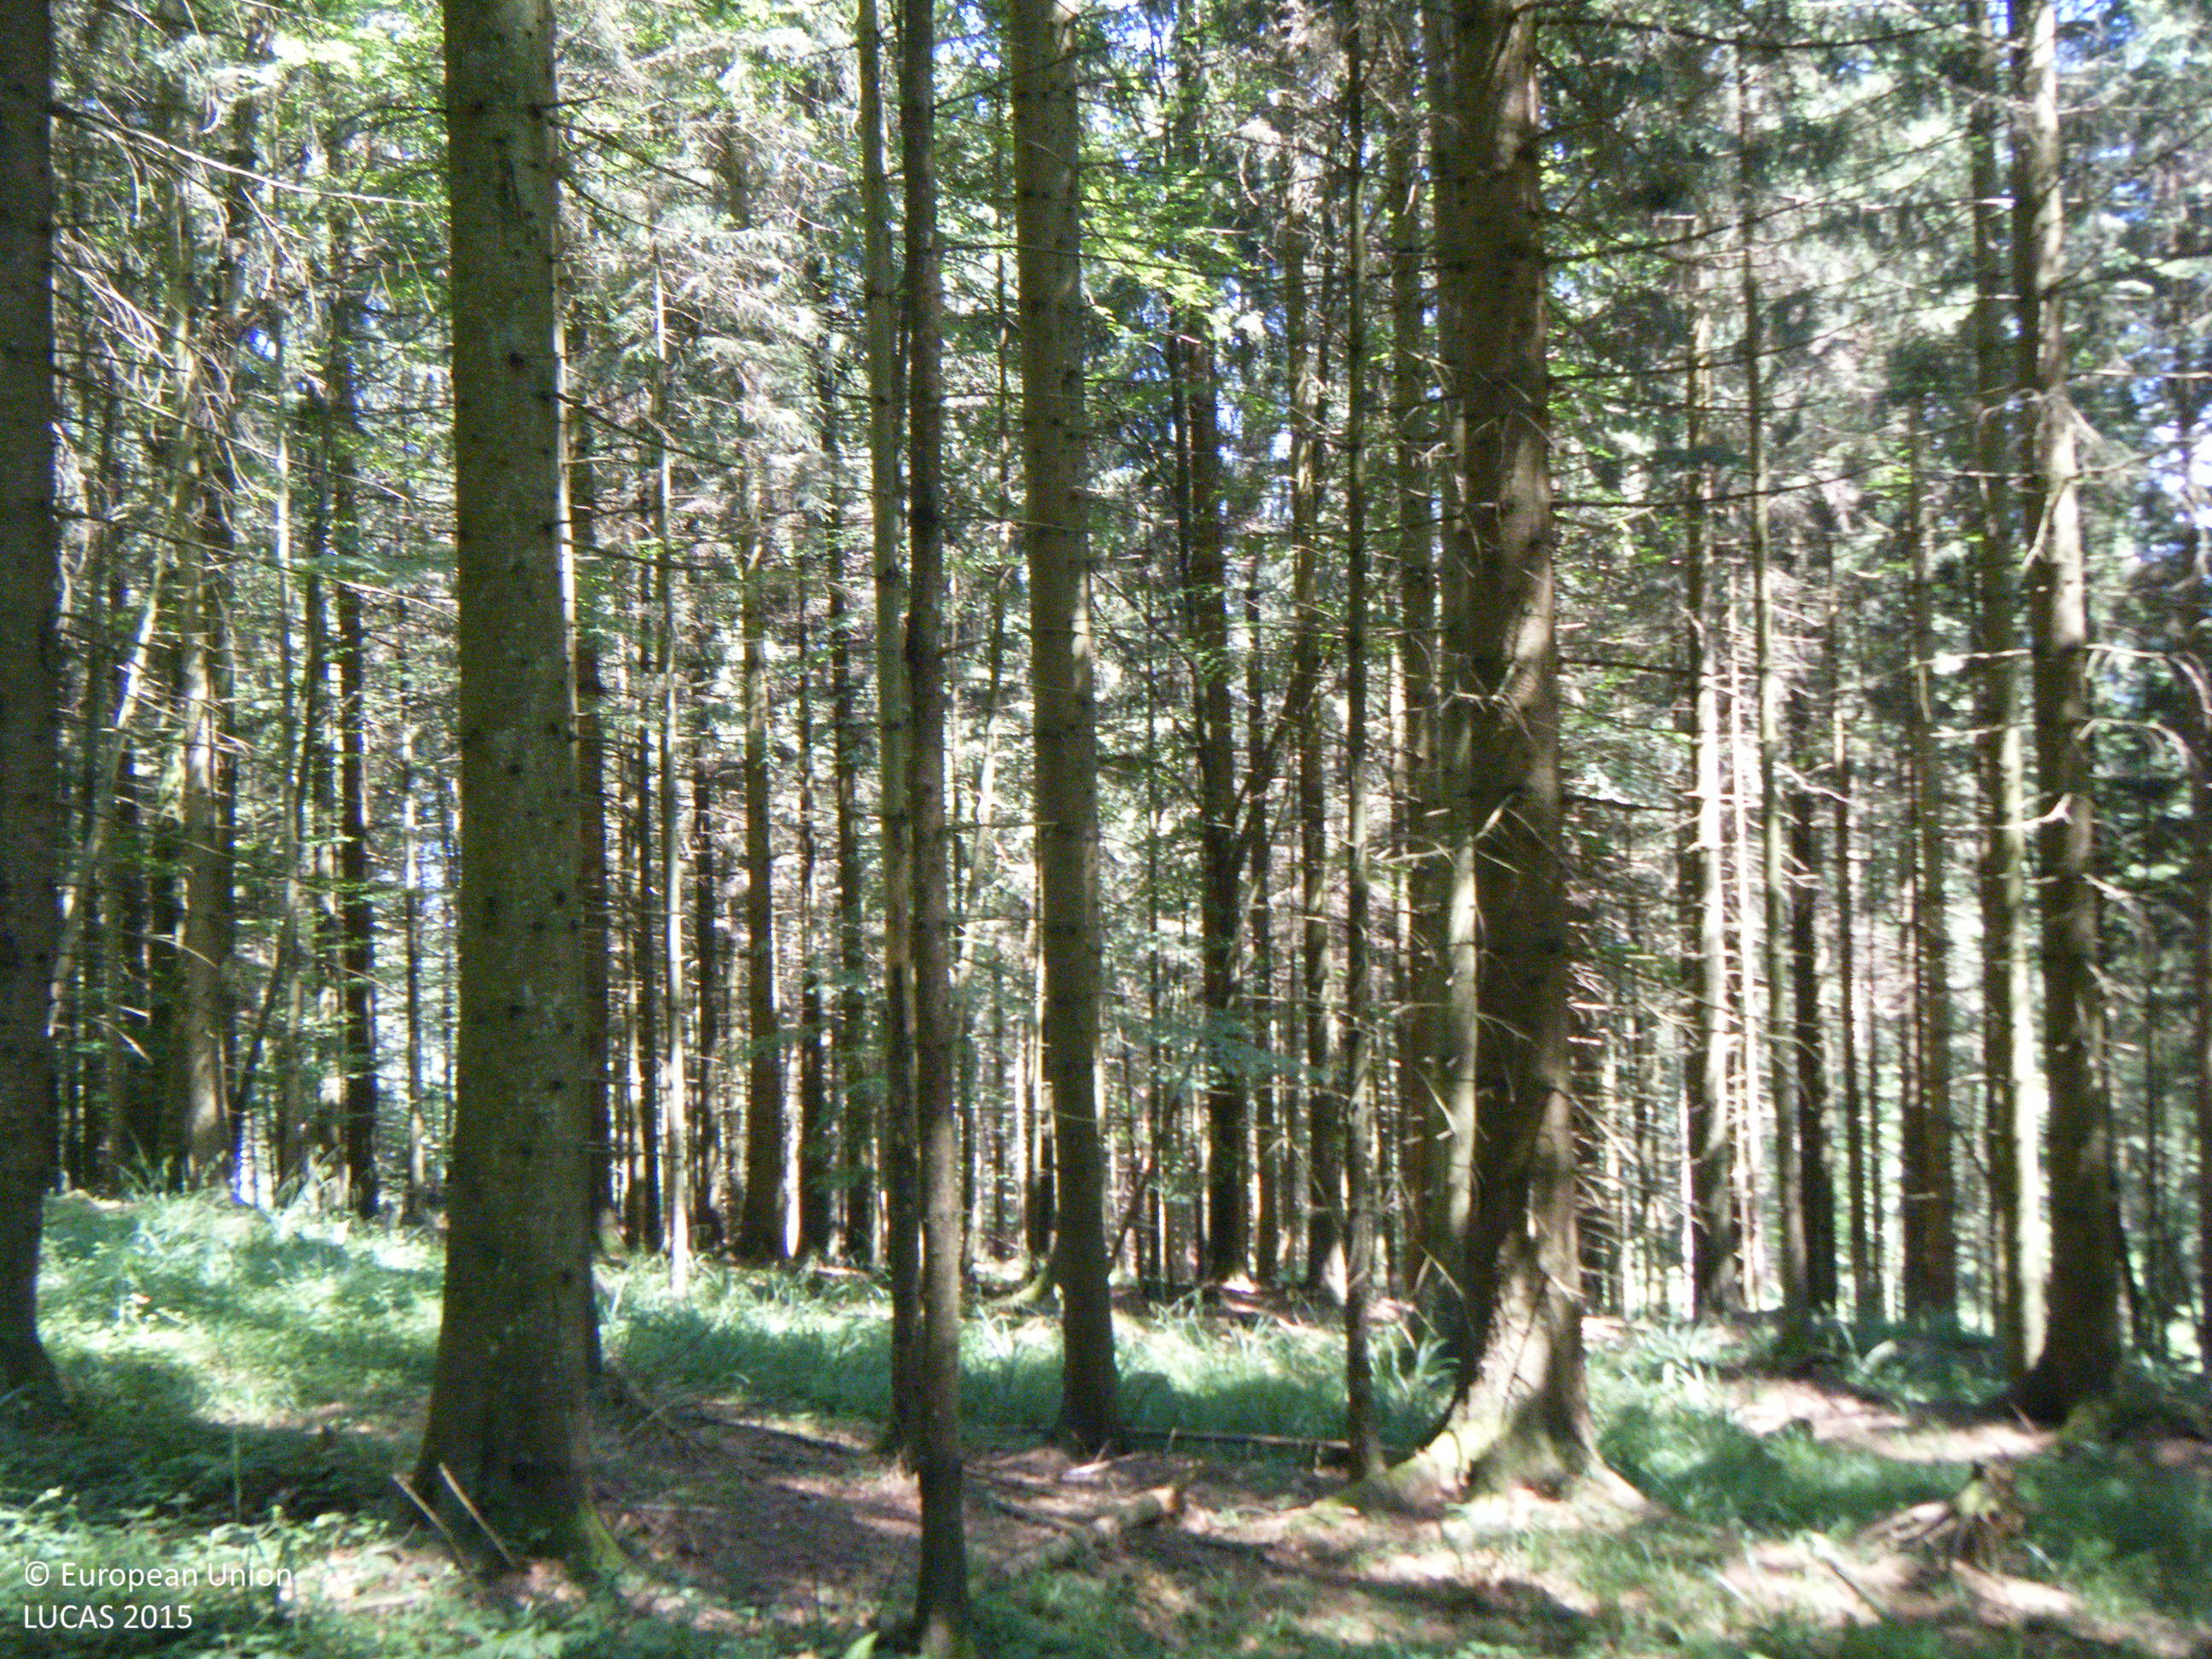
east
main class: Woodland
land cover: Spruce dominated mixed woodland
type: alpine coniferous forest
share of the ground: > 75 %
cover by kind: coniferous forest trees 65 %, broadleaved forest trees 25 %, herbaceous plants 10 %
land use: Forestry
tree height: > 5 m
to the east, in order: Spruce dominated mixed woodland; Spruce dominated coniferous woodland; Ditches and canals; Spruce dominated mixed woodland; Spruce dominated coniferous woodland; Spruce dominated mixed woodland; Rivers and streams; Spruce dominated mixed woodland; Broadleaved woodland
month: July
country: AT
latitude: 47.8622
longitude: 13.4877
